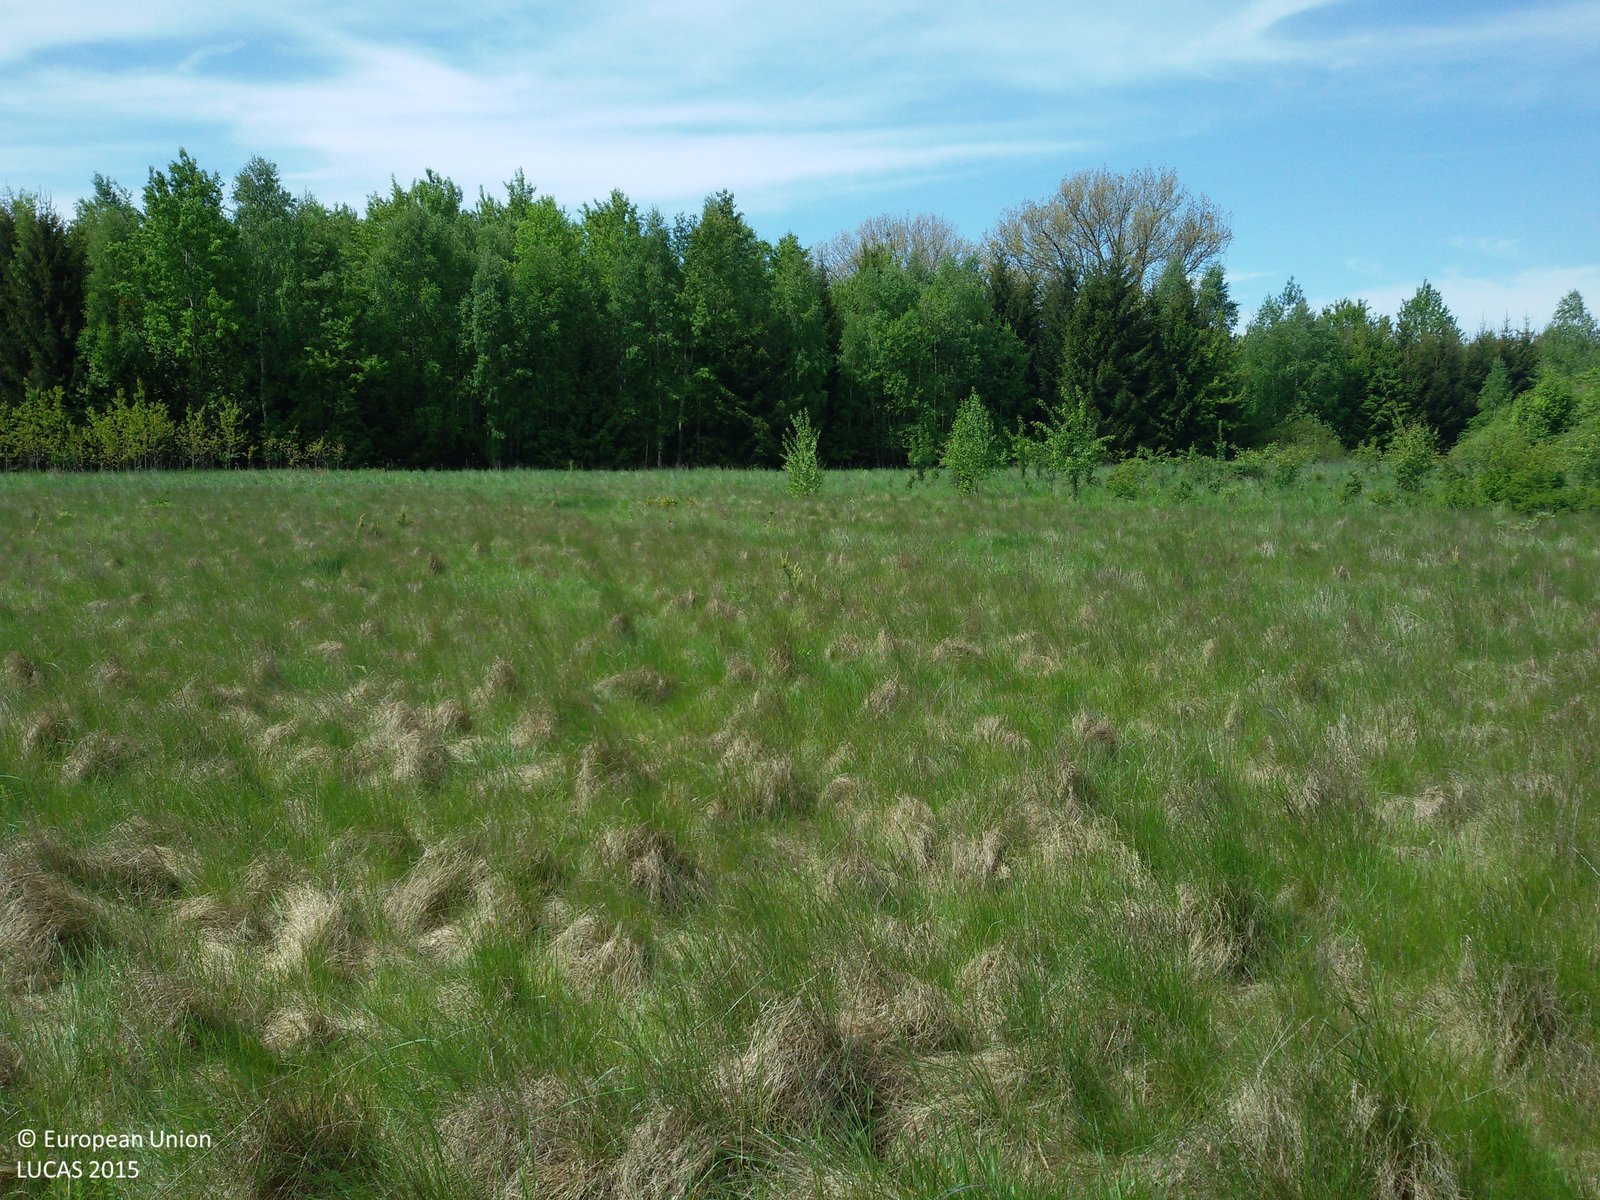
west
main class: Grassland
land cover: Grassland without tree/shrub cover
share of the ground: > 75 %
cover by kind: herbaceous plants 100 %
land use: Semi-natural and natural areas not in use
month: May
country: PL
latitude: 51.9996
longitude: 20.7175
